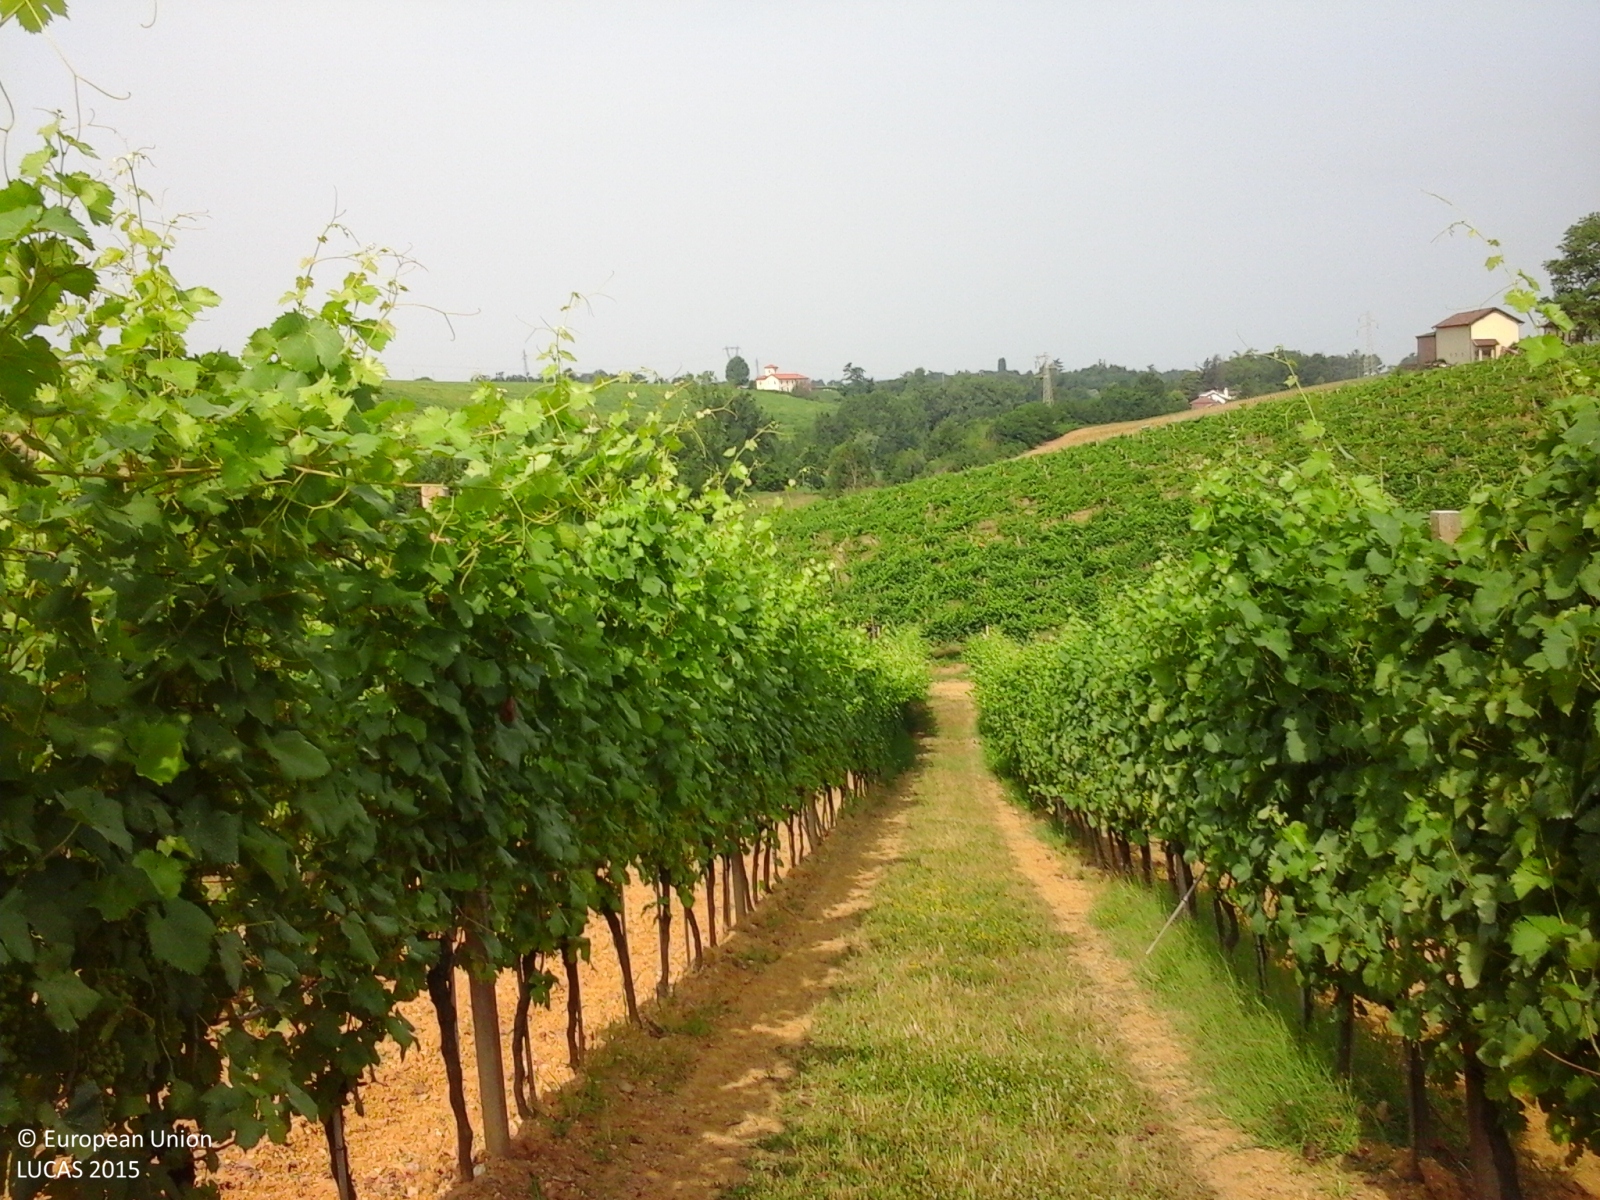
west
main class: Cropland
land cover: Vineyards
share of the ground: 25 - 50 %
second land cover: Grassland without tree/shrub cover
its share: > 75 %
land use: Agriculture (excluding fallow land and kitchen gardens)
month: July
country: IT
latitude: 44.7404
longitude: 8.8027
